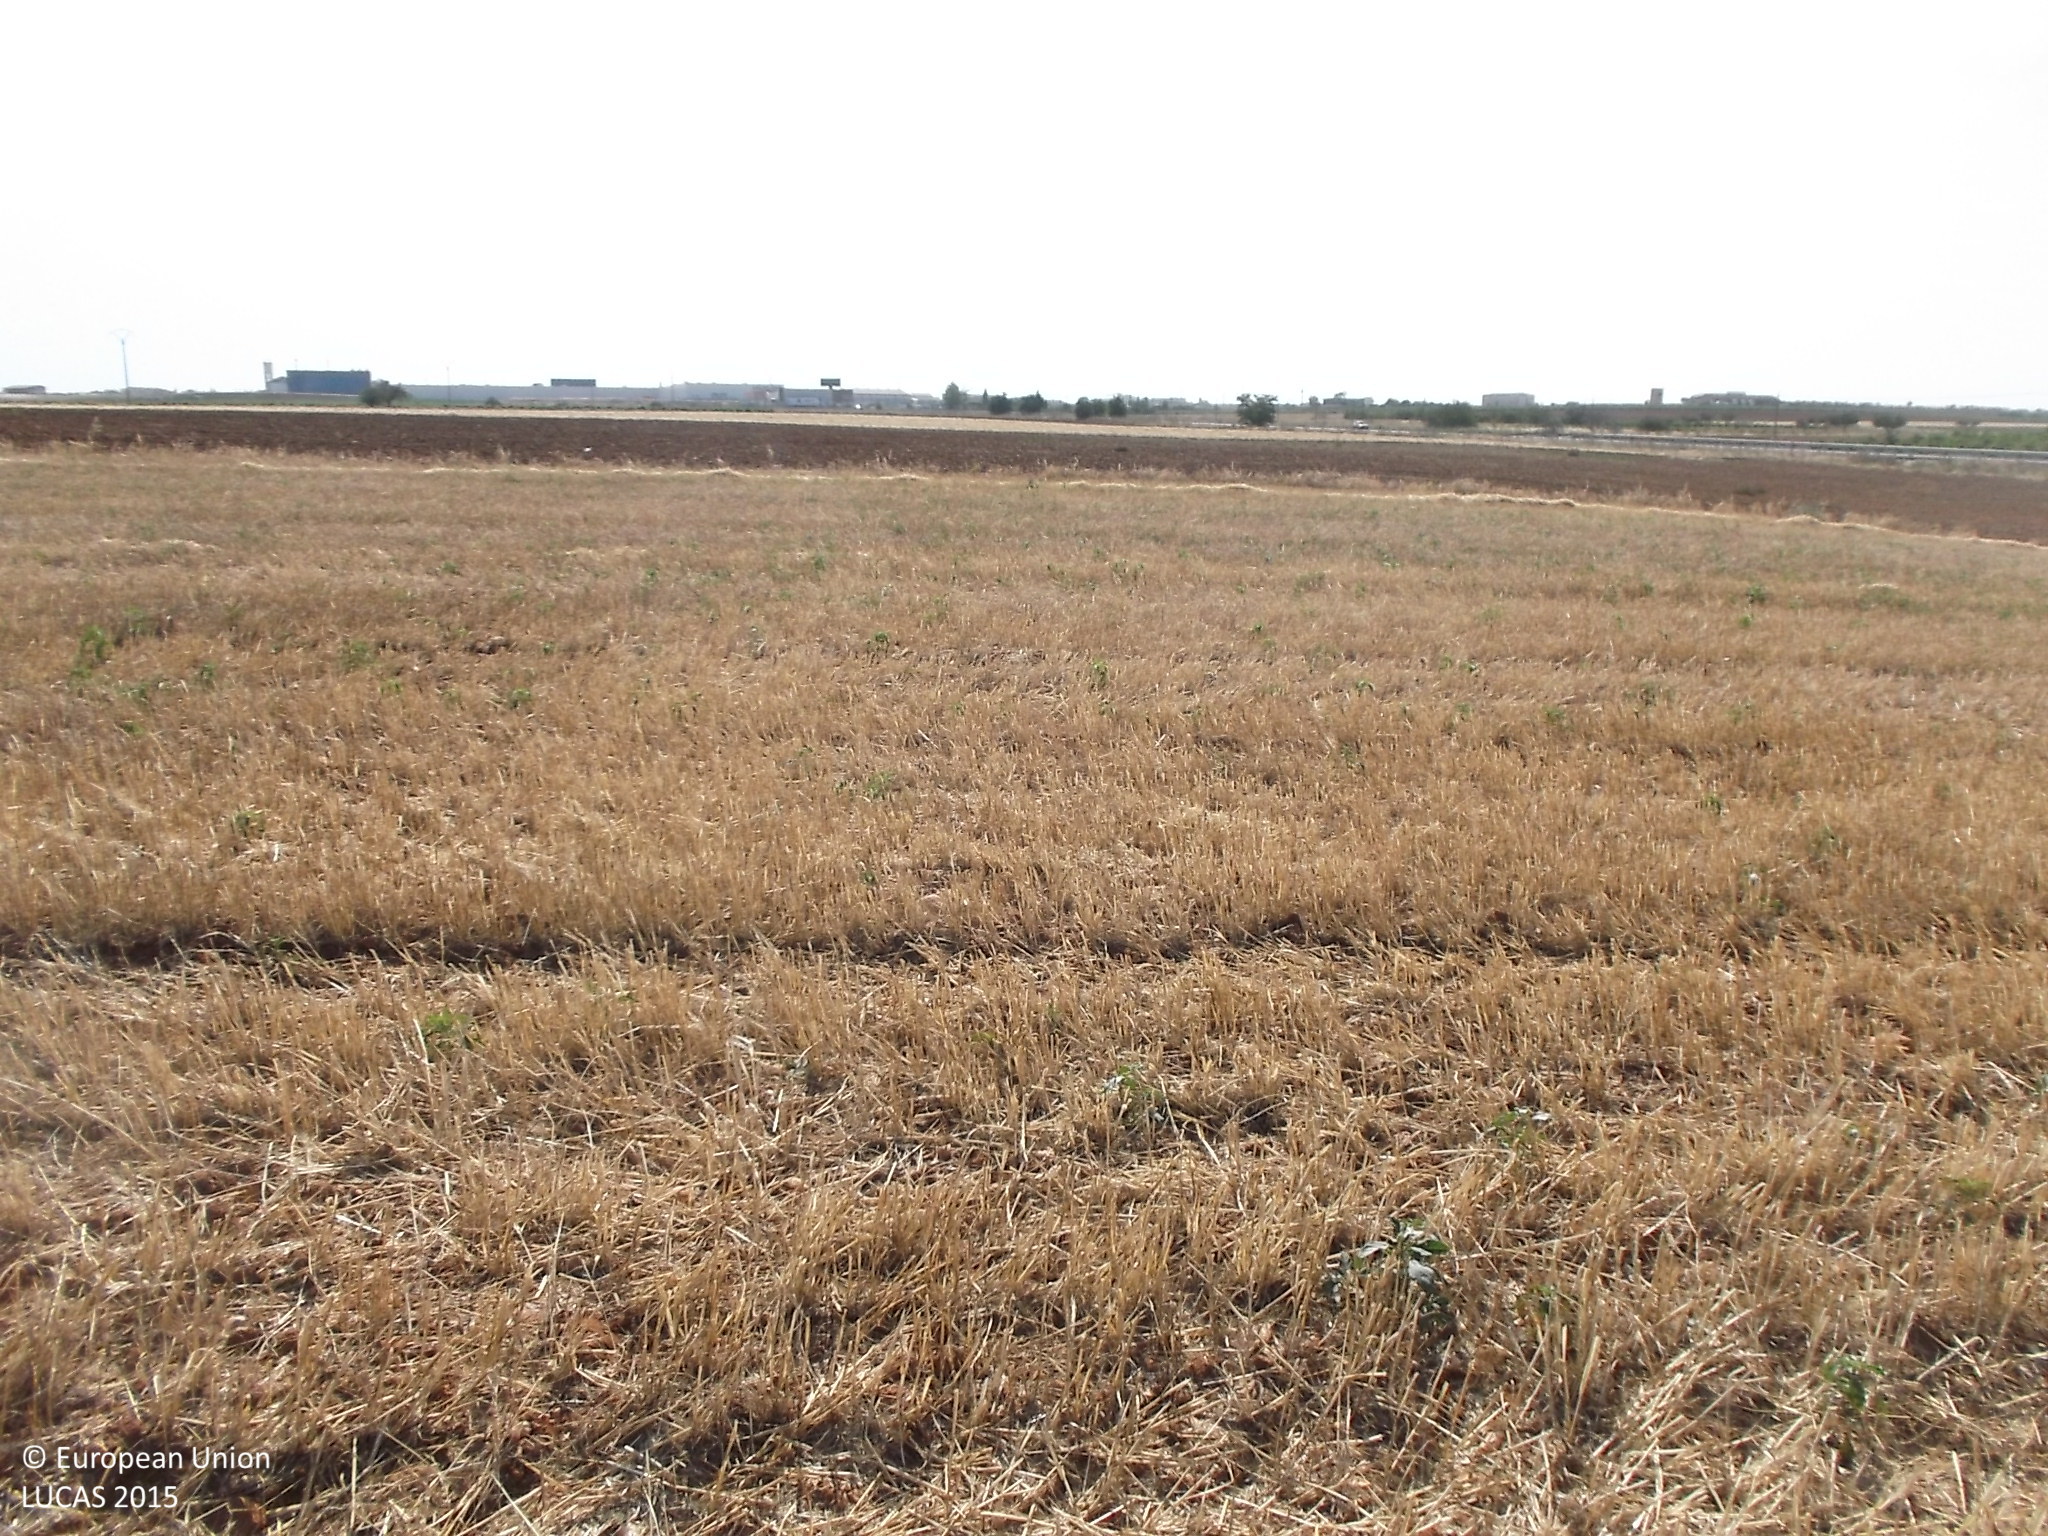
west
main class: Cropland
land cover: Barley
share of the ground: < 10 %
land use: Agriculture (excluding fallow land and kitchen gardens)
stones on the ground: < 10 %
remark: Harvested field
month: July
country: ES
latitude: 41.5294
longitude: -5.3599
